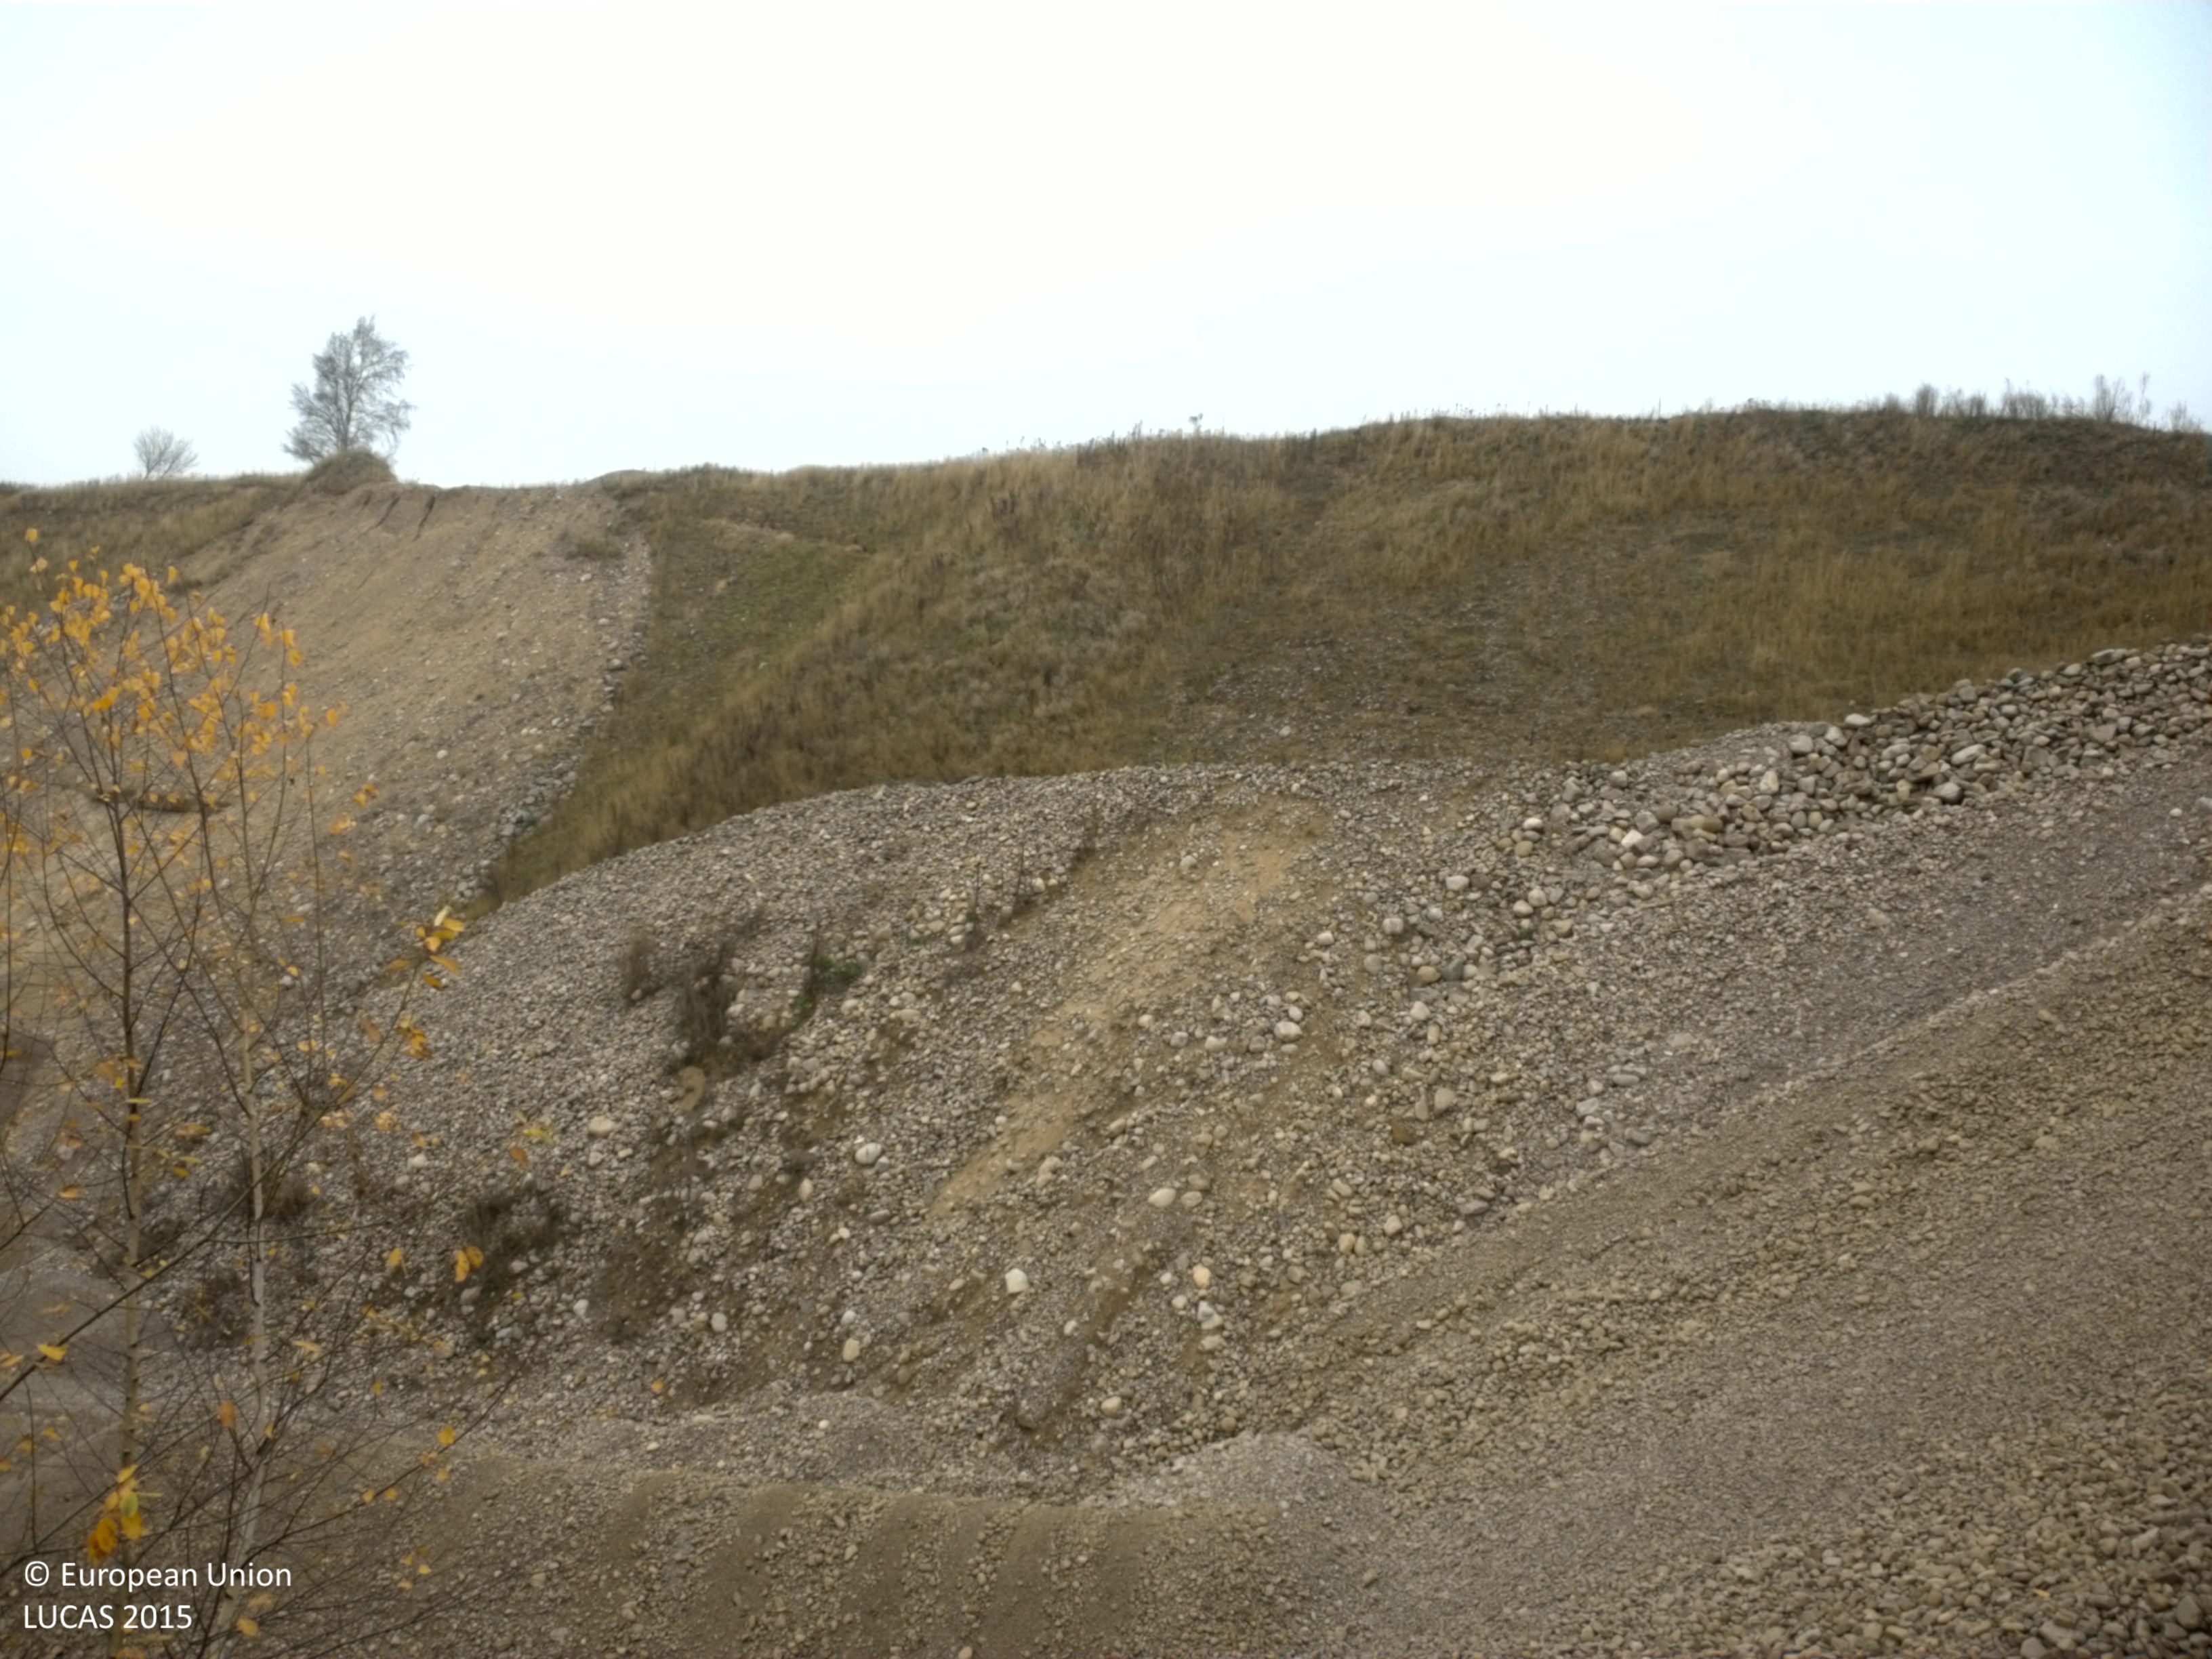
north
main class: Woodland
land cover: Broadleaved woodland
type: hemiboreal forest and nemoral coniferous forest and mixed broadleaved-coniferous forest
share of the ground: 10 - 25 %
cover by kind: herbaceous plants 80 %, broadleaved forest trees 20 %
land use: Mining and quarrying
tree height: < 5 m
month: November
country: SE
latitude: 56.1151
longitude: 13.0693
